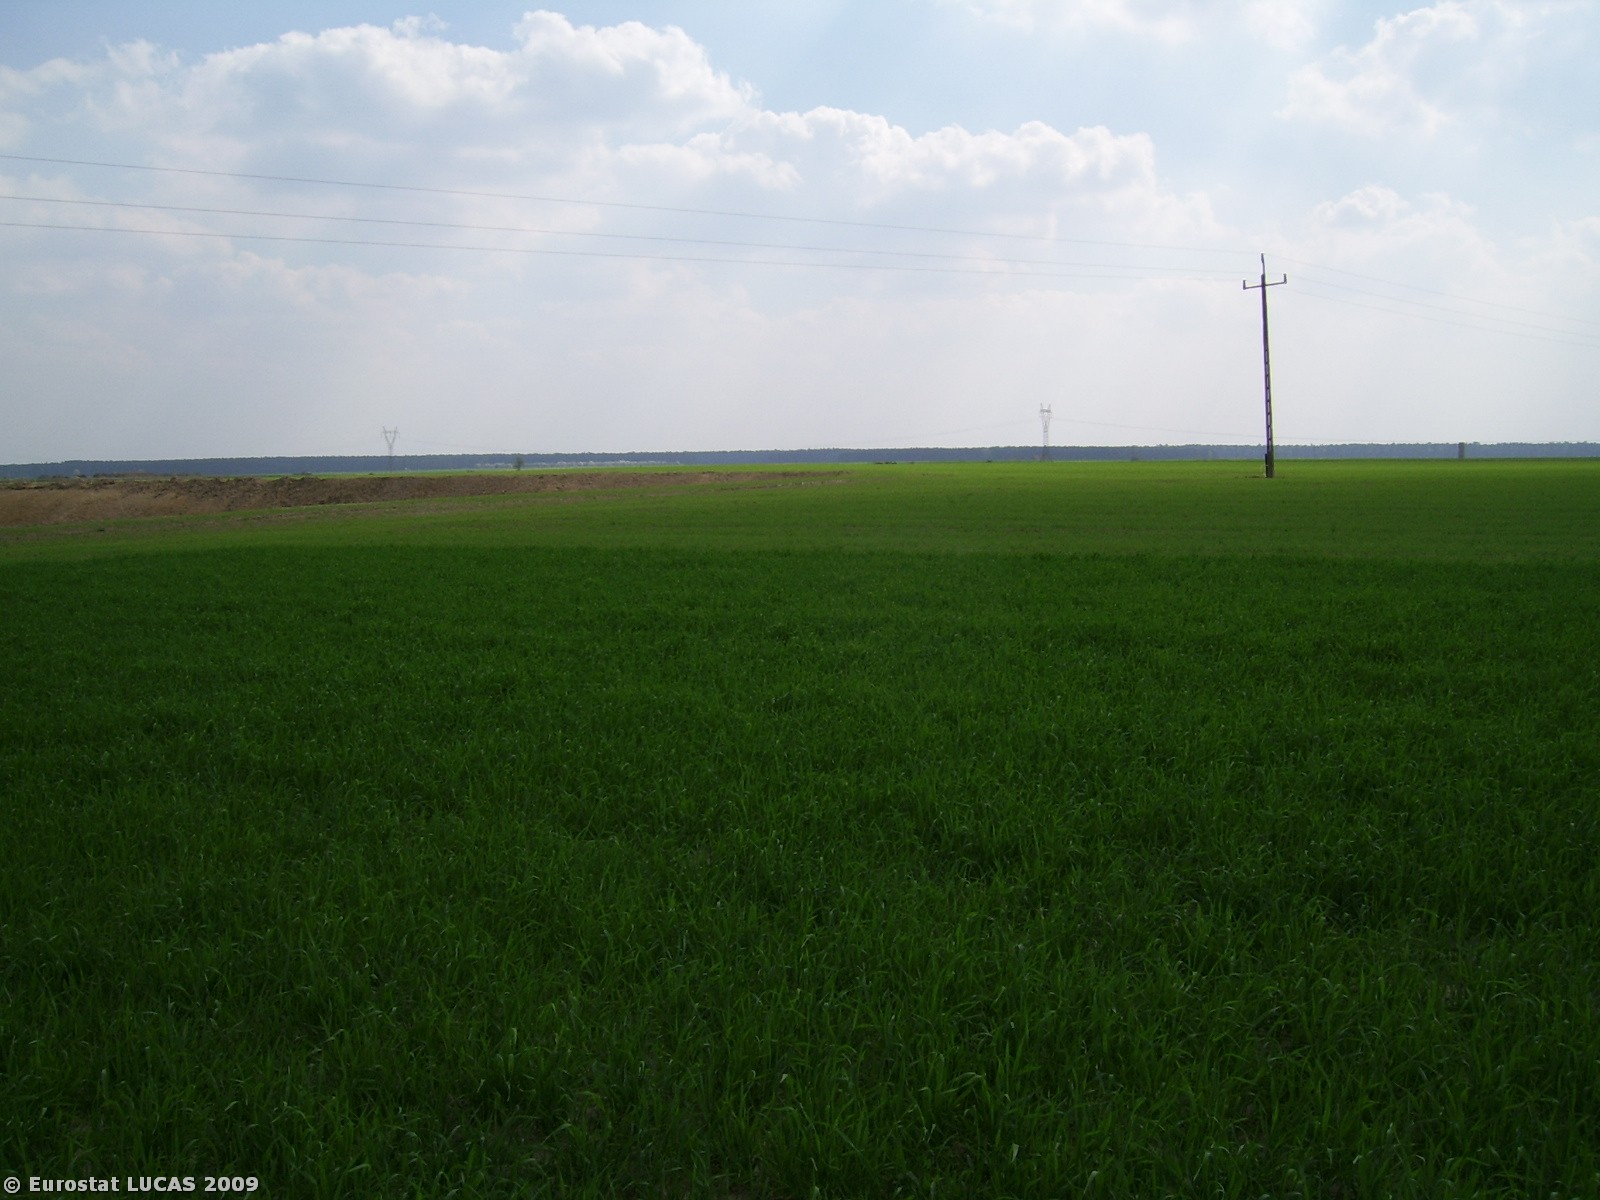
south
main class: Cropland
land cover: Rye
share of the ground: > 75 %
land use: Agriculture (excluding fallow land and kitchen gardens)
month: April
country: PL
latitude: 52.3003
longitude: 16.9458
